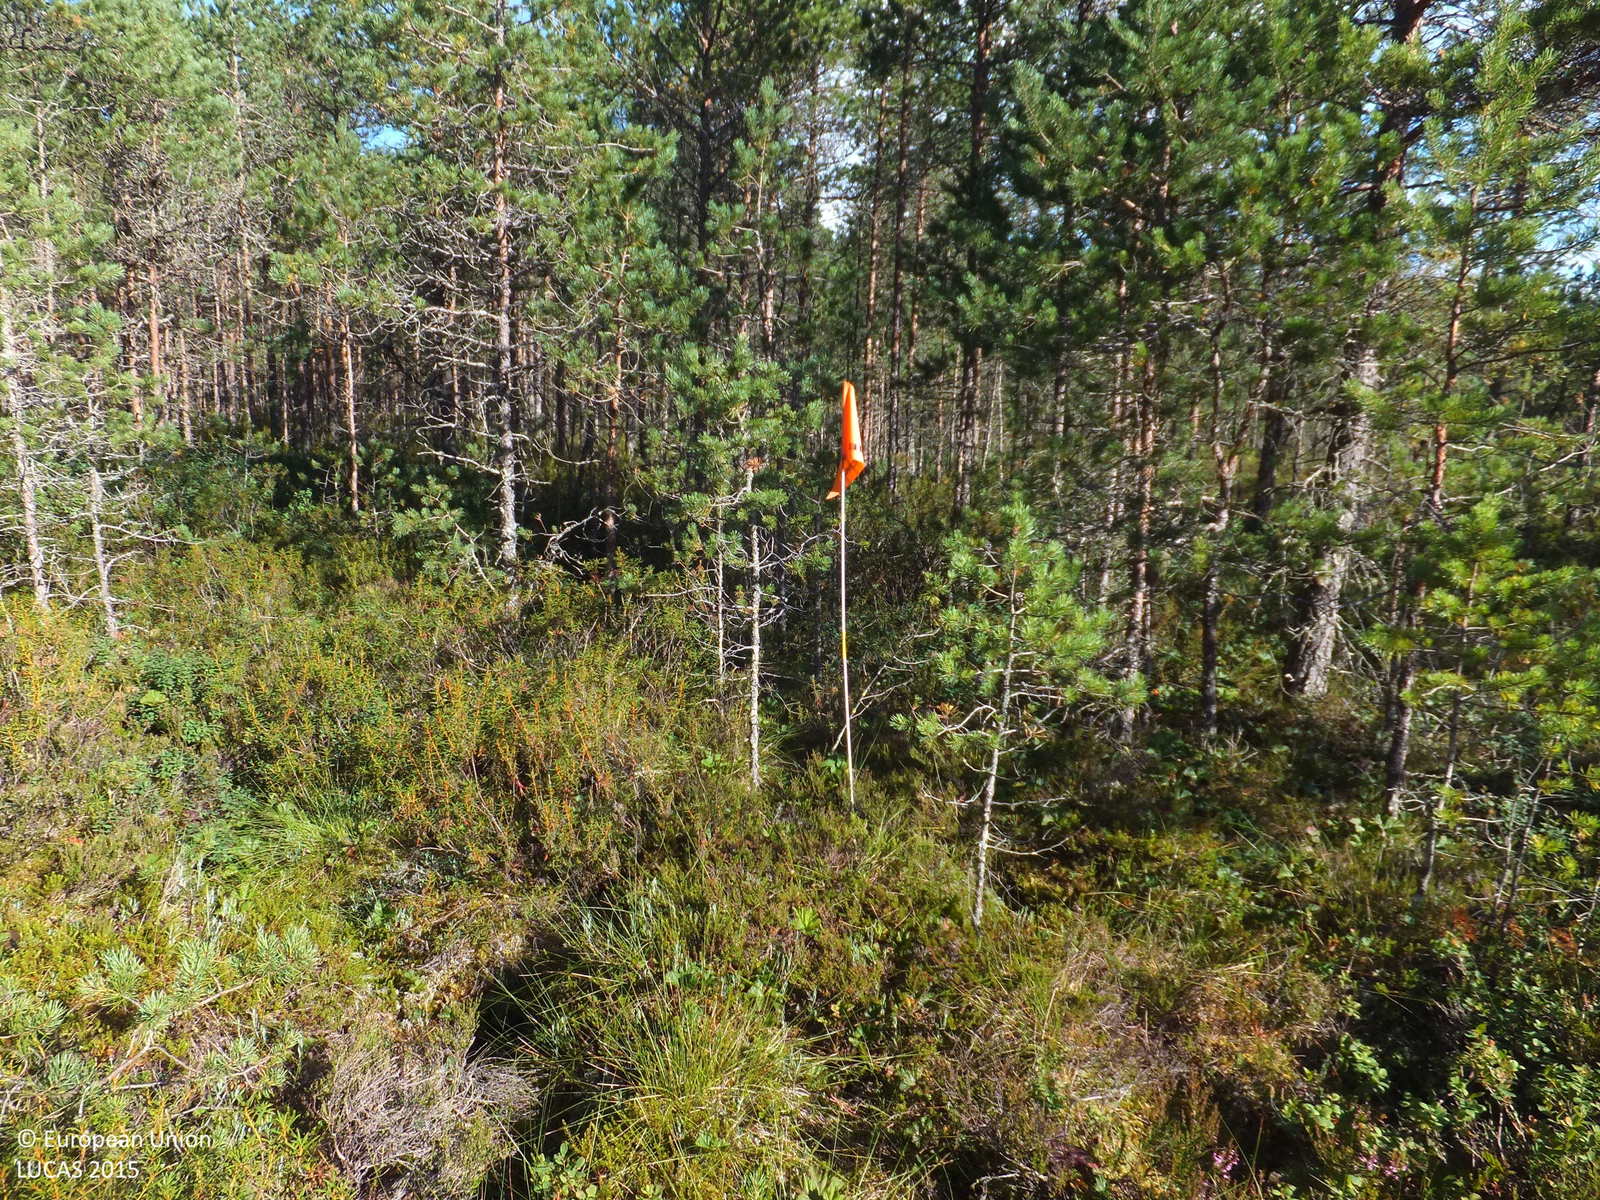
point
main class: Woodland
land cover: Pine dominated coniferous woodland
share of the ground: 50 - 75 %
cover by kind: coniferous forest trees 50 %, shrubs 30 %, lichens and mosses 15 %, herbaceous plants 5 %
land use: Forestry
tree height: < 5 m
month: August
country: FI
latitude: 63.1044
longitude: 22.8357
